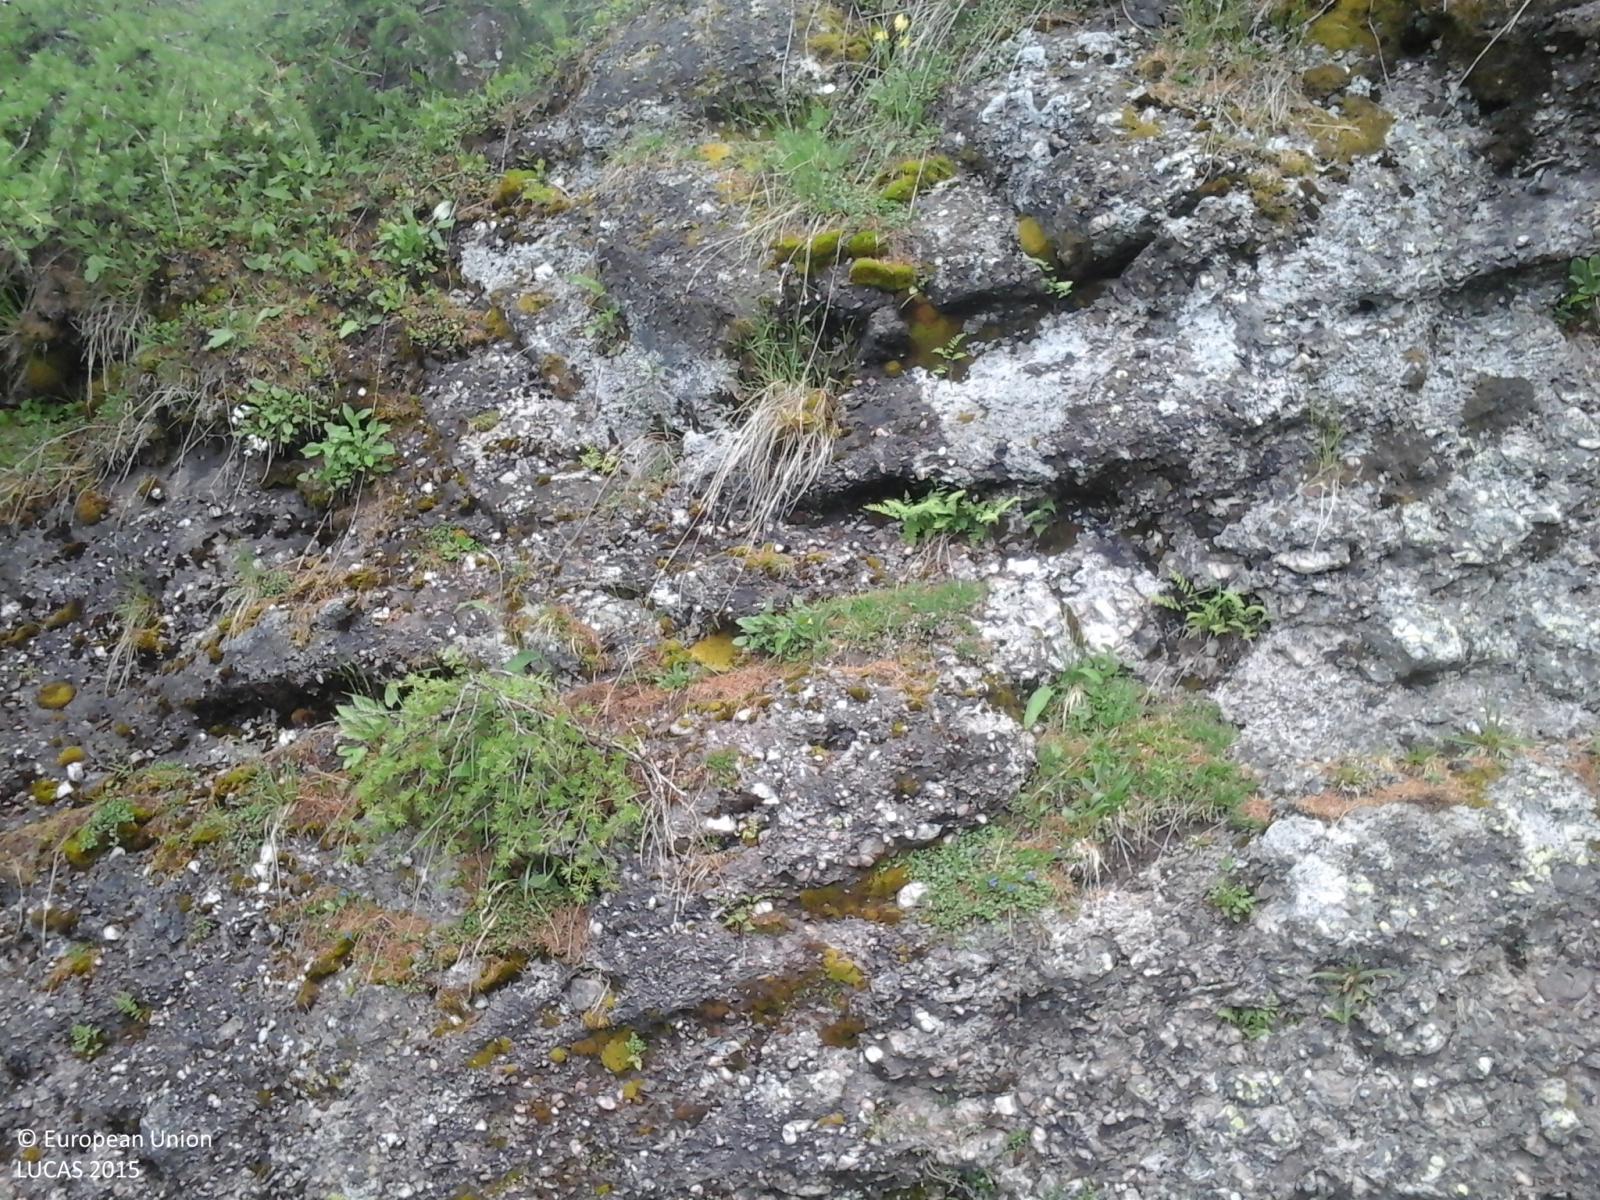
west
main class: Woodland
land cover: Other coniferous woodland
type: alpine coniferous forest
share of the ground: > 75 %
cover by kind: coniferous forest trees 90 %, shrubs 10 %
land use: Semi-natural and natural areas not in use
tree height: > 5 m
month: June
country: IT
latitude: 46.6657
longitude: 12.4416
